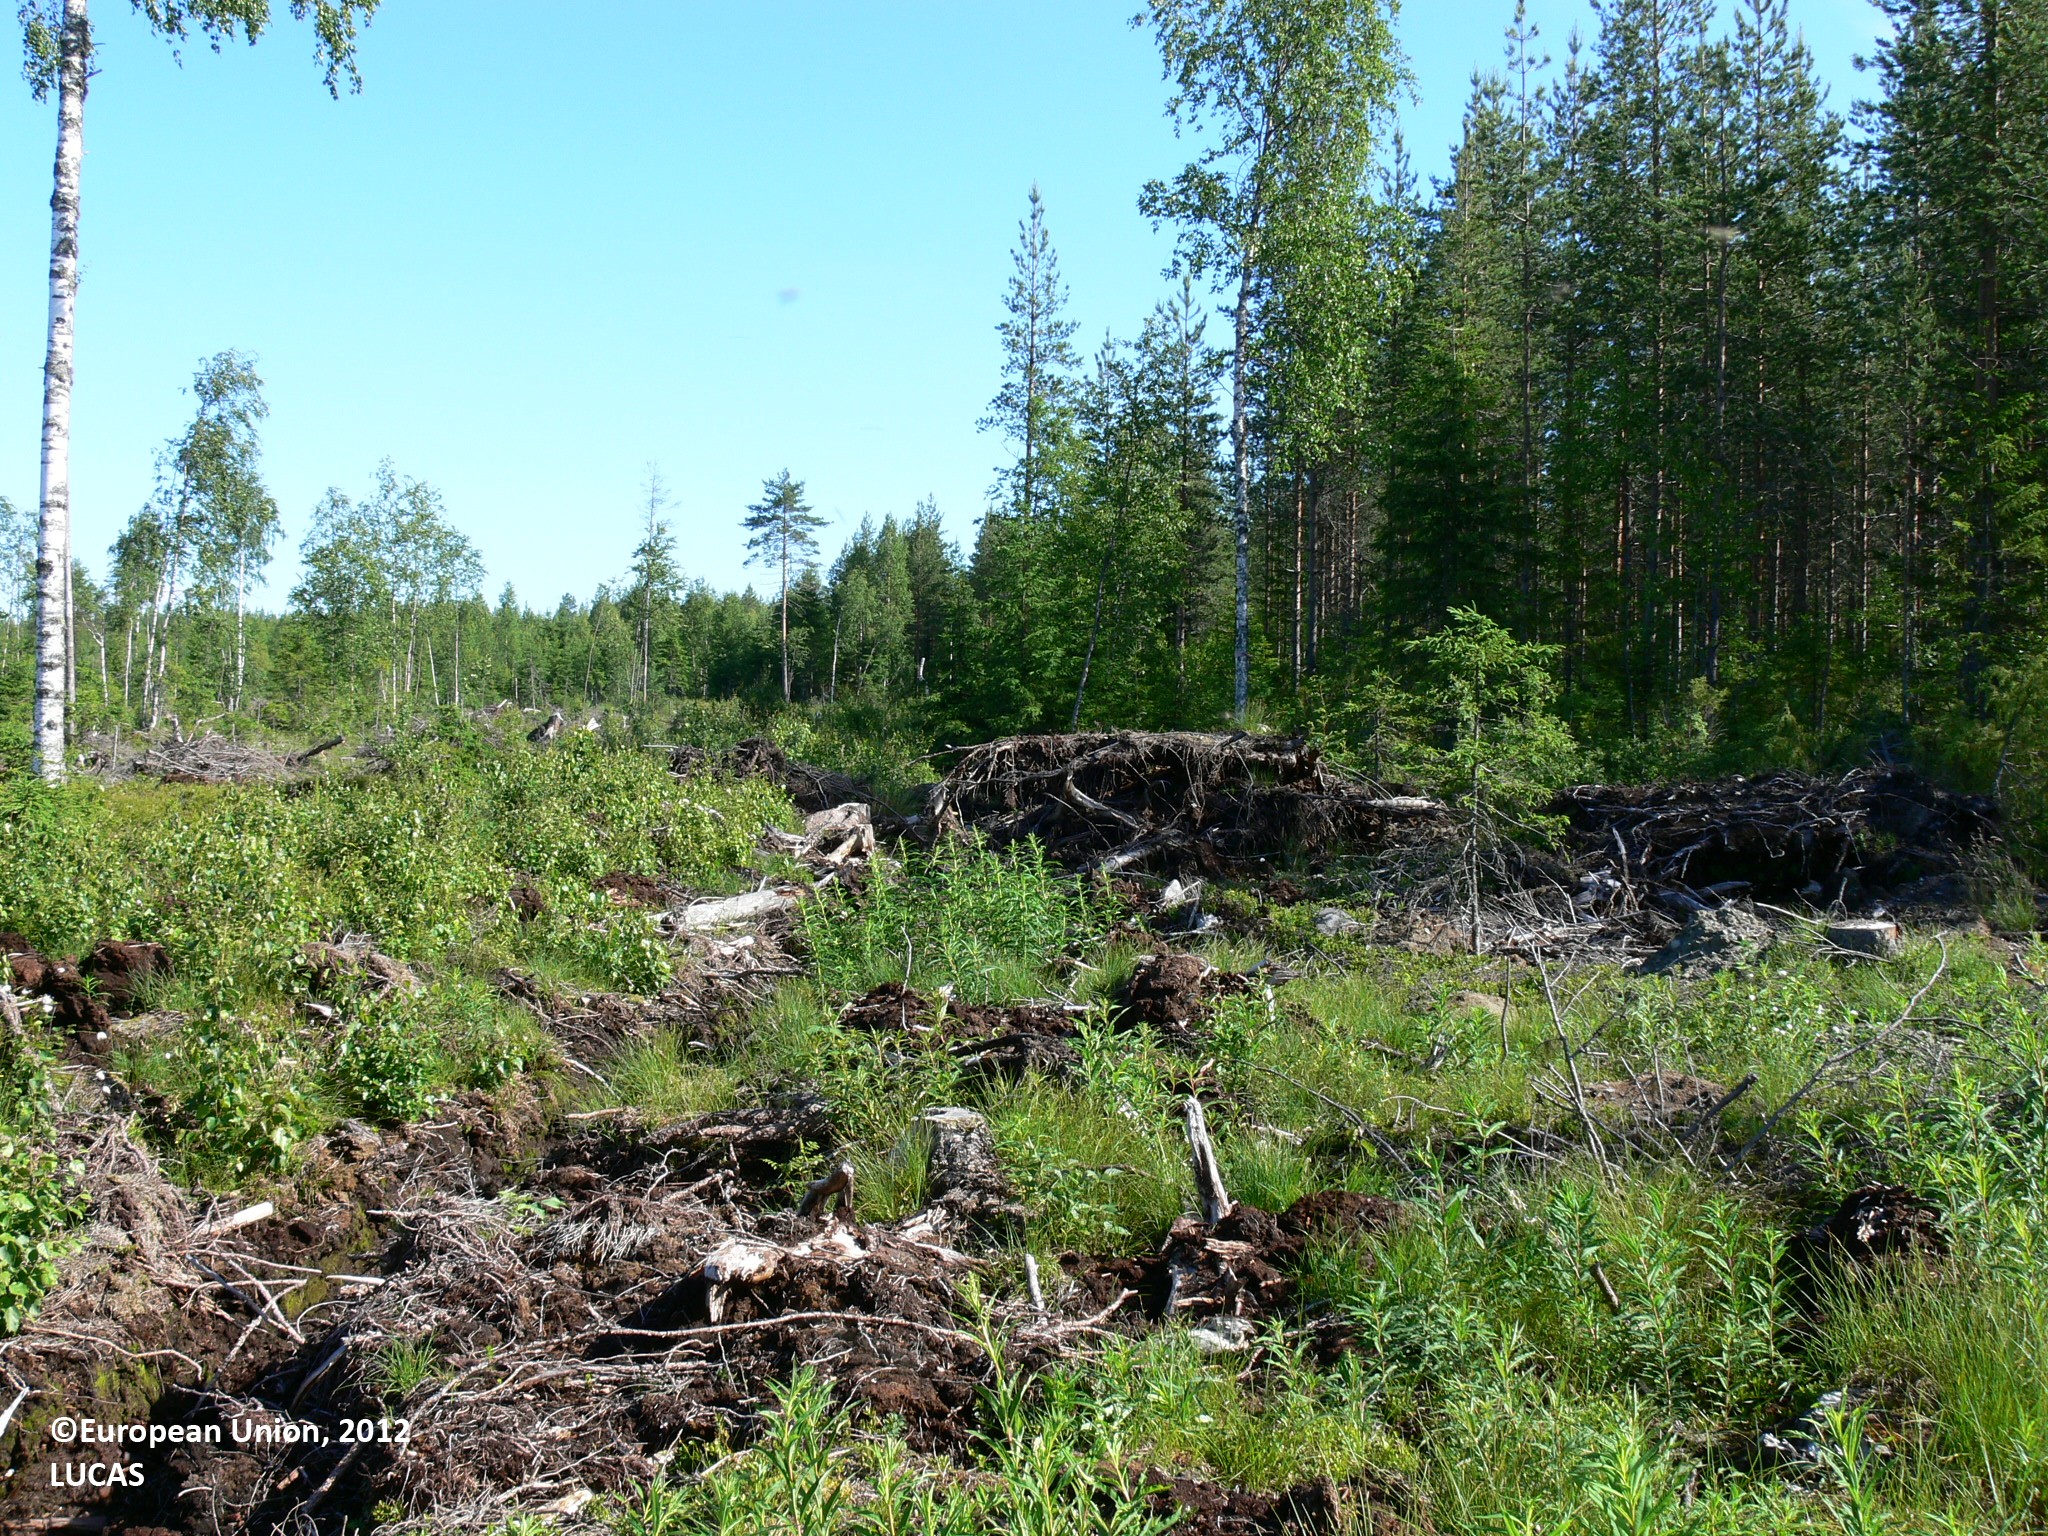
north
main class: Woodland
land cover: Broadleaved woodland
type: boreal forest
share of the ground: 10 - 25 %
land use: Forestry
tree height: < 5 m
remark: Clear cut
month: July
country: FI
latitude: 62.8896
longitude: 29.9013
